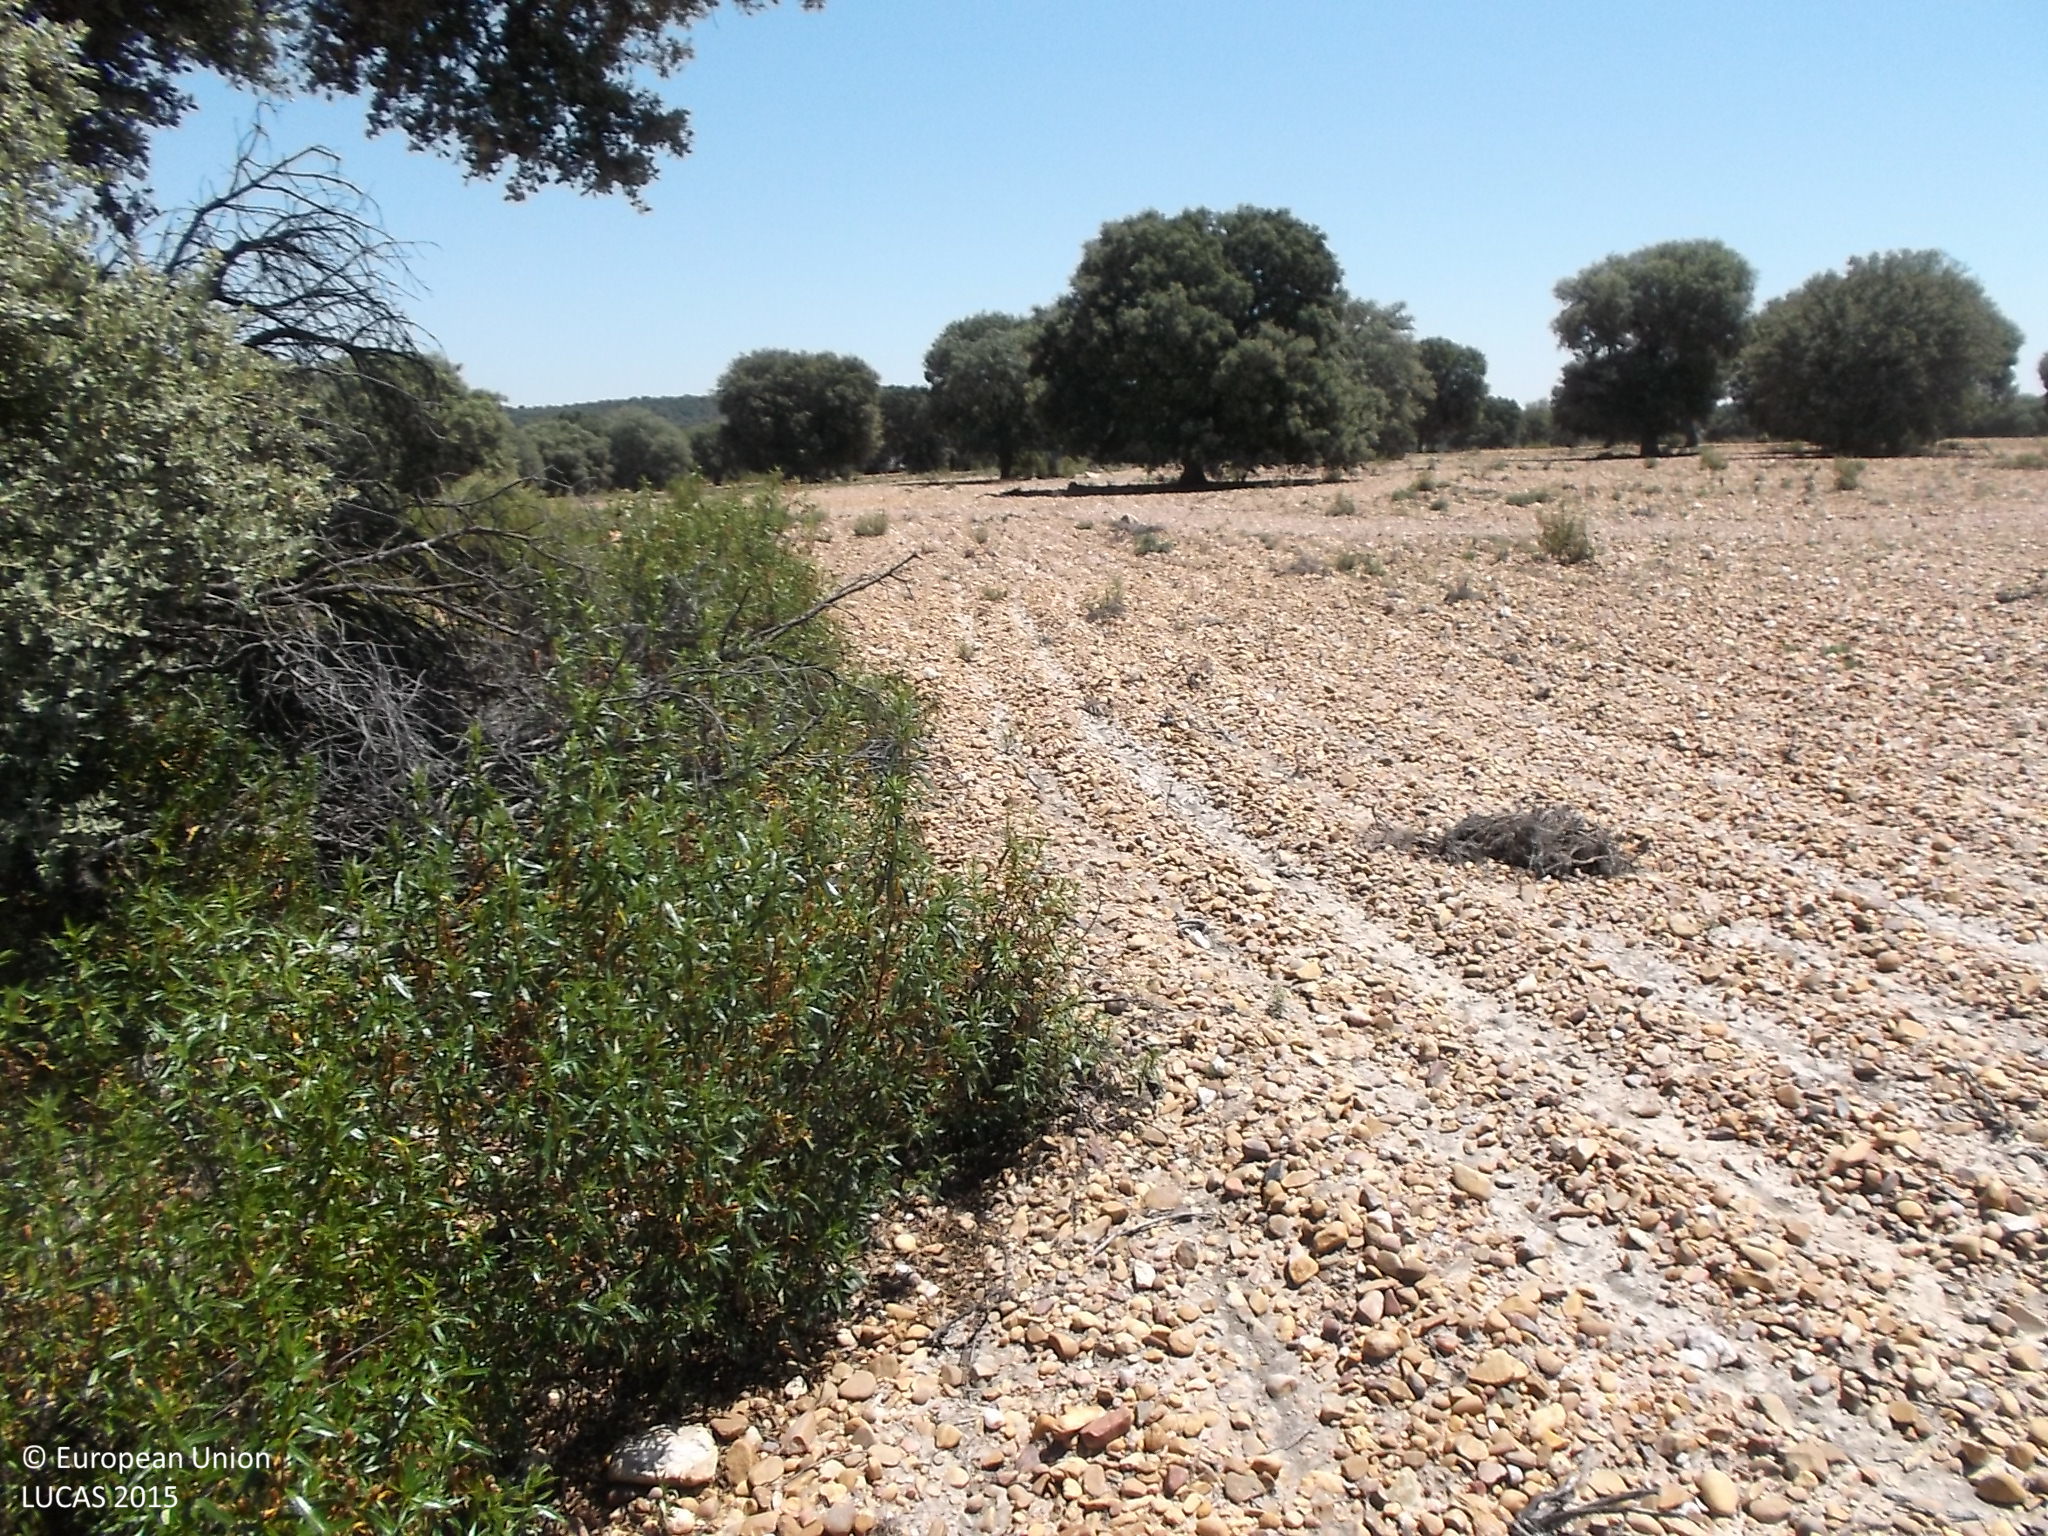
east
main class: Woodland
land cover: Broadleaved woodland
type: broadleaved evergreen forest
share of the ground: 10 - 25 %
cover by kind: unconsolidated bare surface 80 %, broadleaved forest trees 20 %
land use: Forestry
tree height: < 5 m
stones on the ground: 10 - 25 %
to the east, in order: Broadleaved woodland; Other bare soil; Broadleaved woodland; Tracks; Shruby margins; Fences; Shrubland with sparse tree cover; Shrubland without tree cover
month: July
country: ES
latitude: 41.5042
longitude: -5.8670
